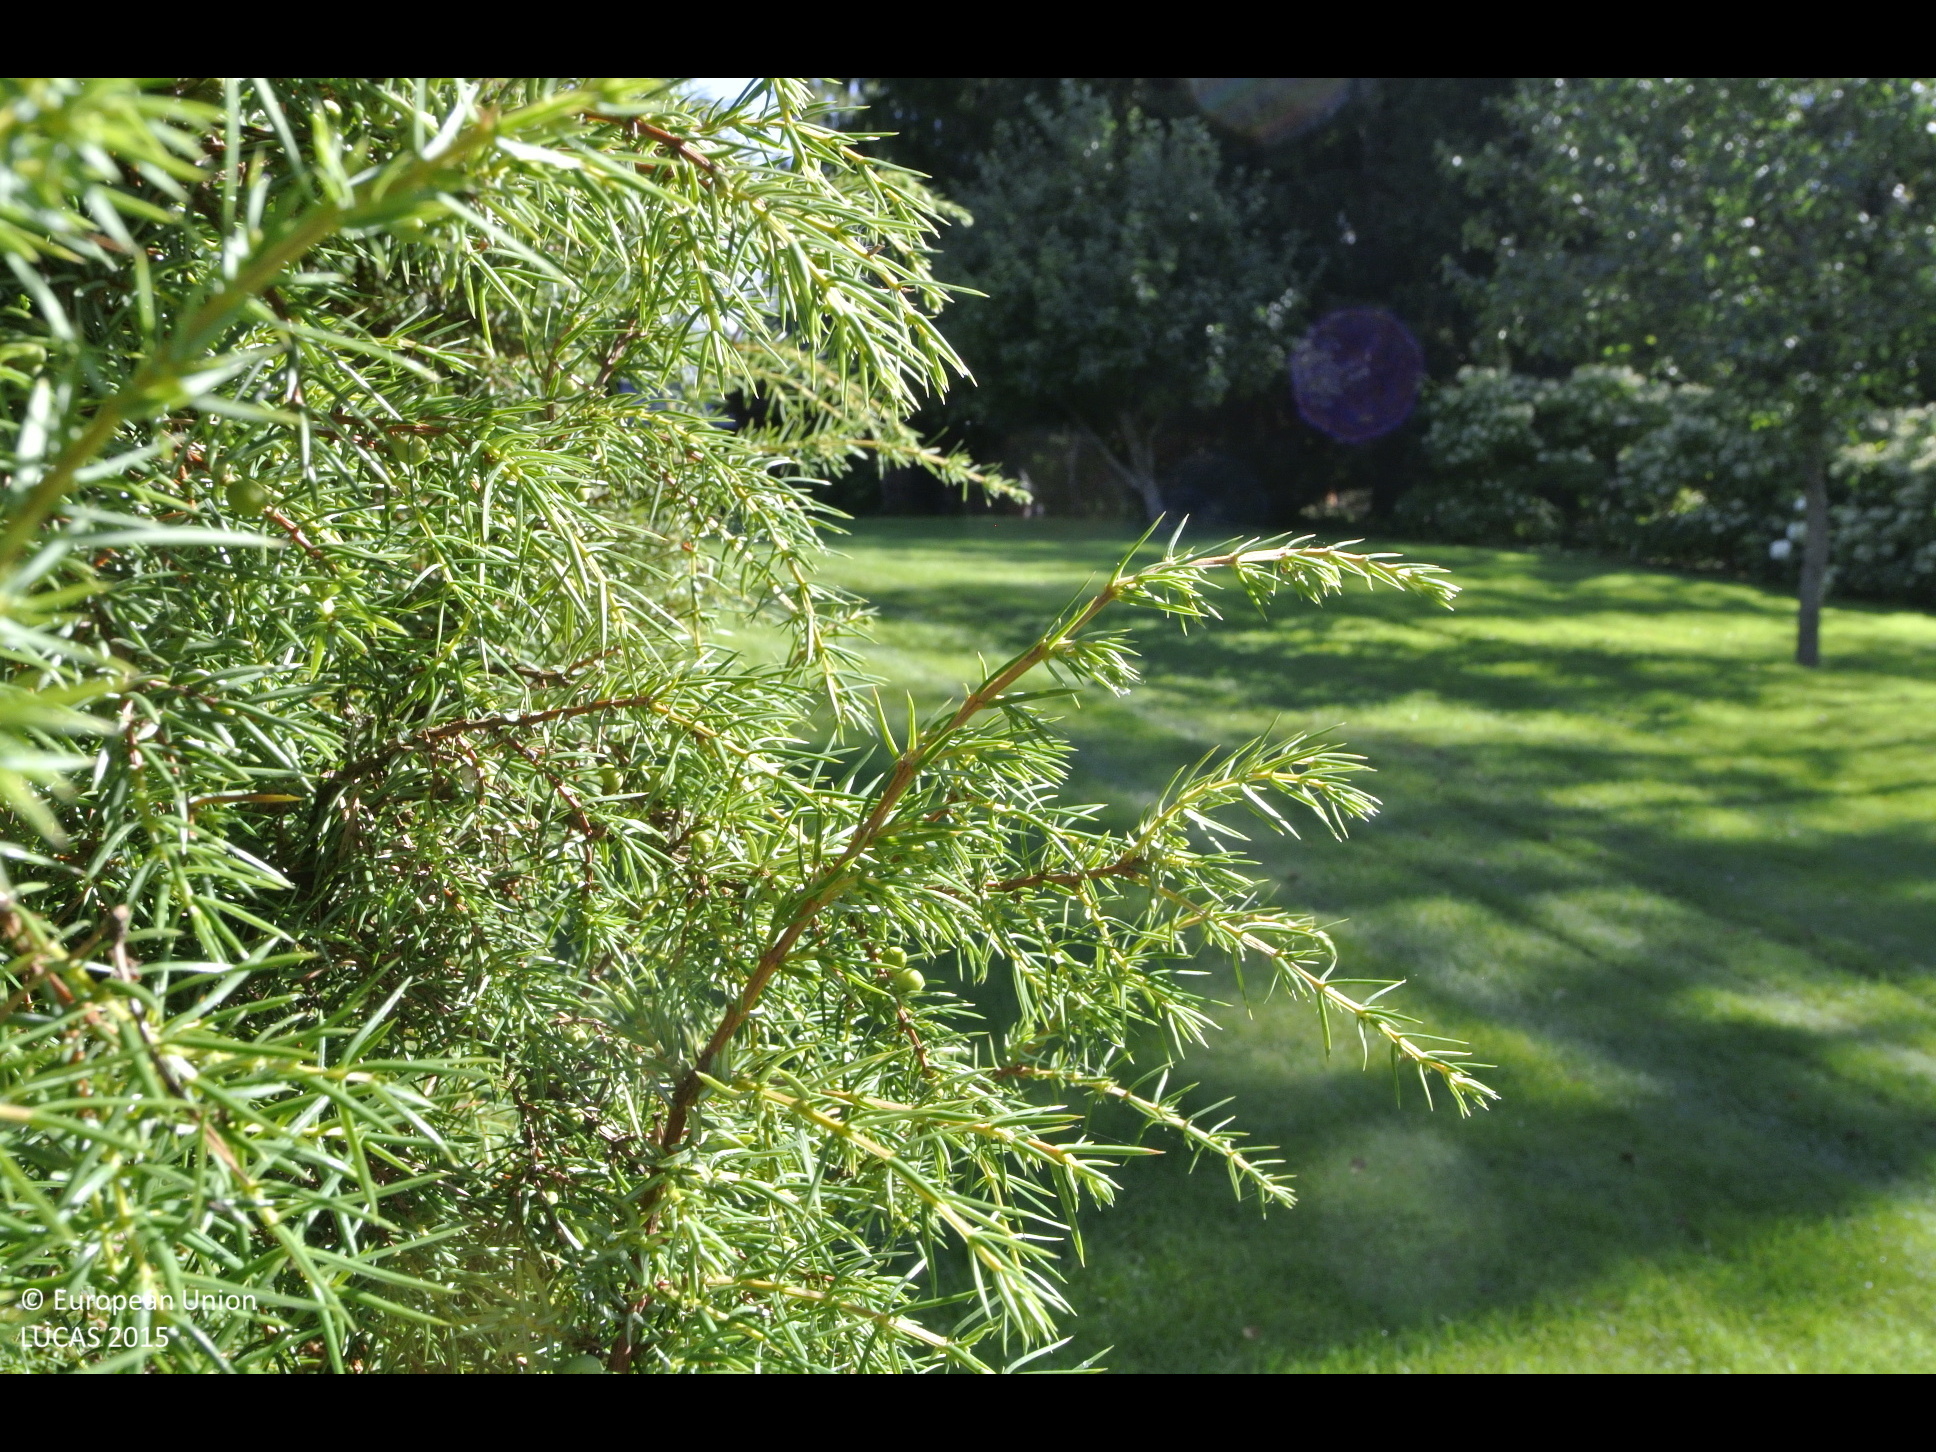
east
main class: Grassland
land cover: Grassland without tree/shrub cover
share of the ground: > 75 %
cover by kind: herbaceous plants 100 %
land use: Residential
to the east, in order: Grassland without tree/shrub cover; Artificial constructions in urban areas; Other mixed woodland; Artificial constructions in urban areas
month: September
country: FI
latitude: 60.2496
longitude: 25.2096
